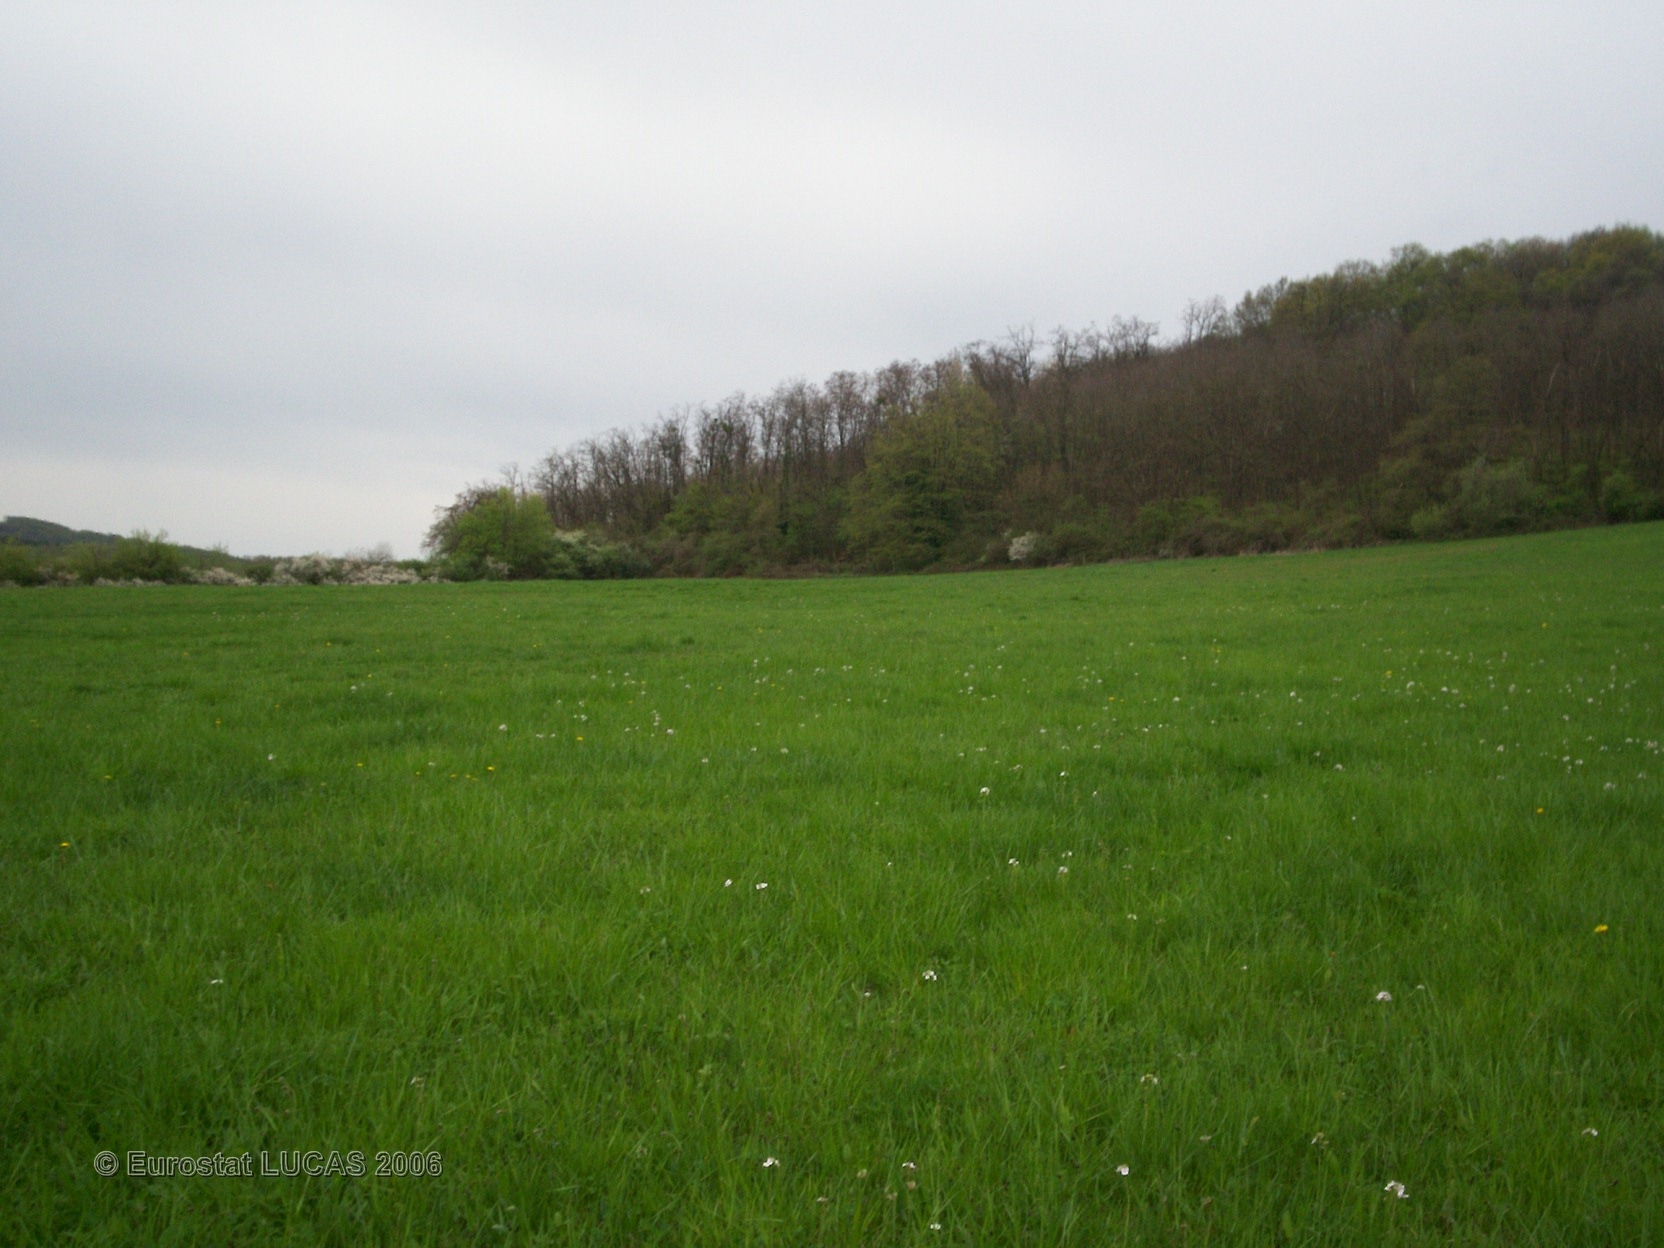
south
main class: Grassland
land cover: Grassland without tree/shrub cover
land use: Agriculture (excluding fallow land and kitchen gardens)
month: April
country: FR
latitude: 46.8317
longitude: 4.6651
